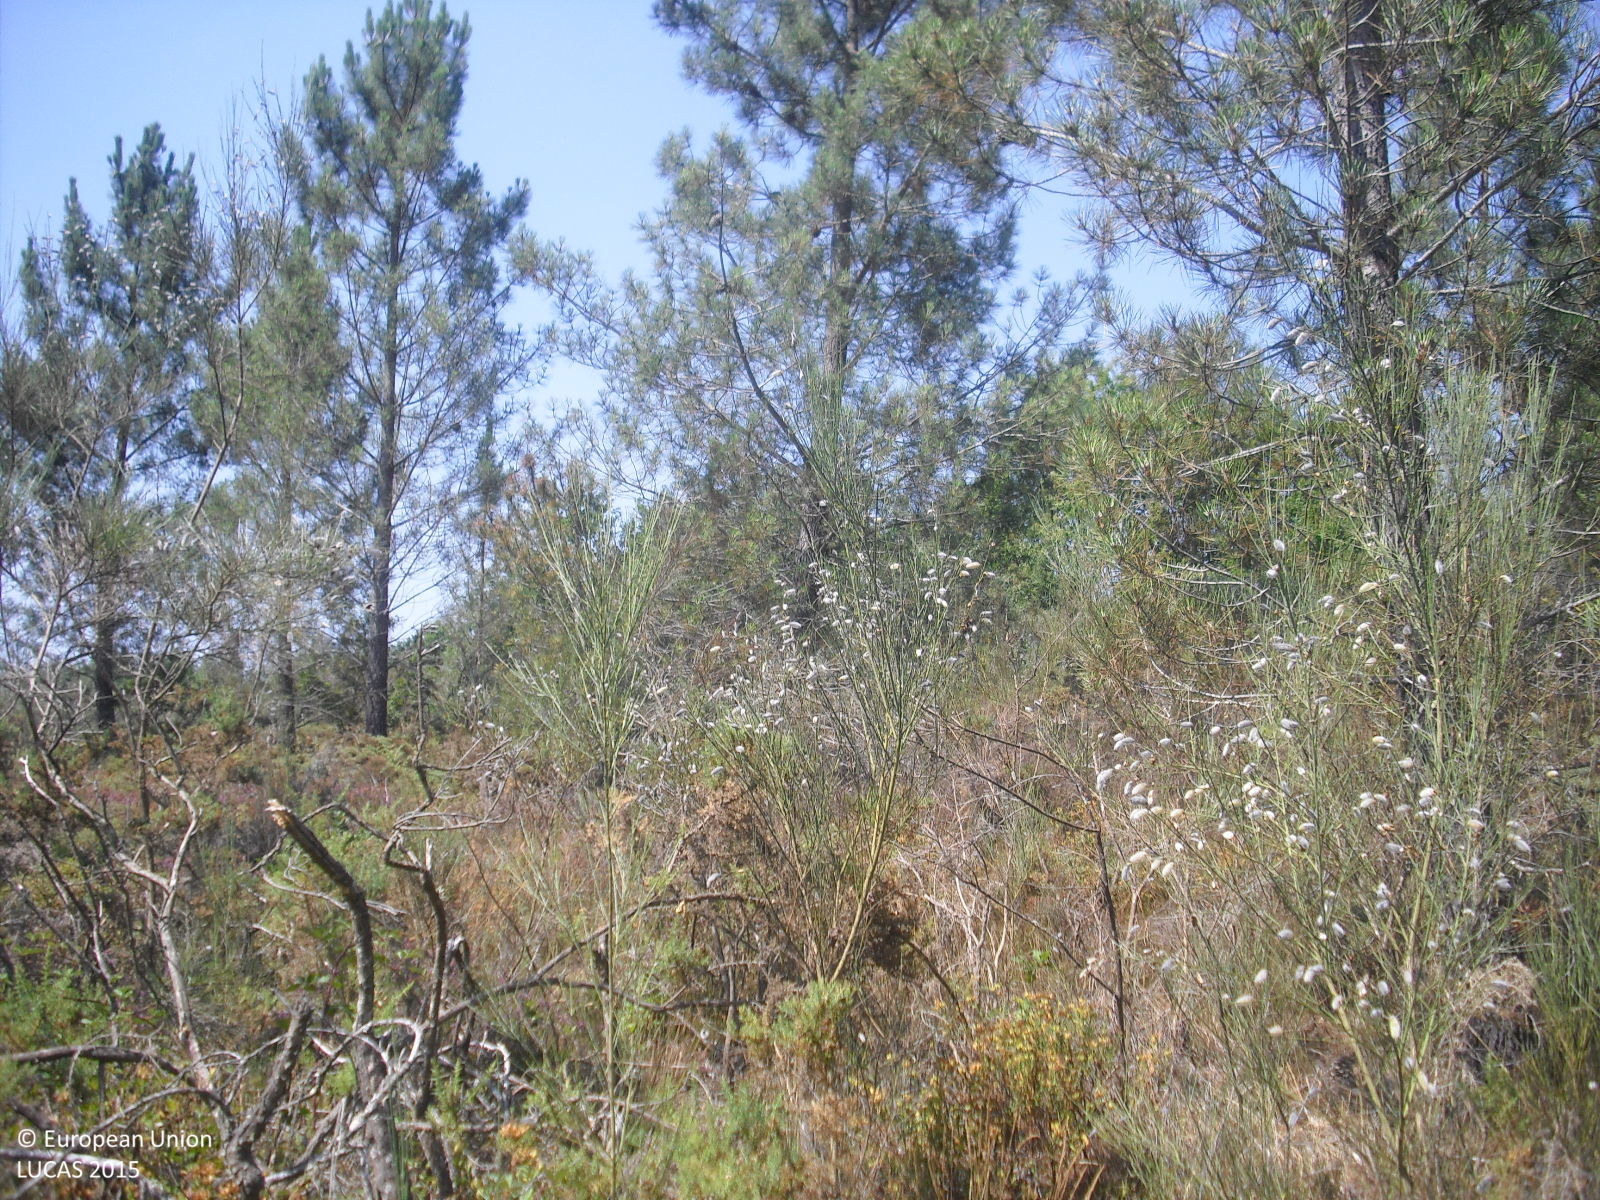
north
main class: Woodland
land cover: Pine dominated mixed woodland
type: hemiboreal forest and nemoral coniferous forest and mixed broadleaved-coniferous forest
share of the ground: 25 - 50 %
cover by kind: shrubs 55 %, coniferous forest trees 30 %, broadleaved forest trees 15 %
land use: Forestry
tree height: > 5 m
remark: Clear cut
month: July
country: ES
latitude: 42.4279
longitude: -7.4853
